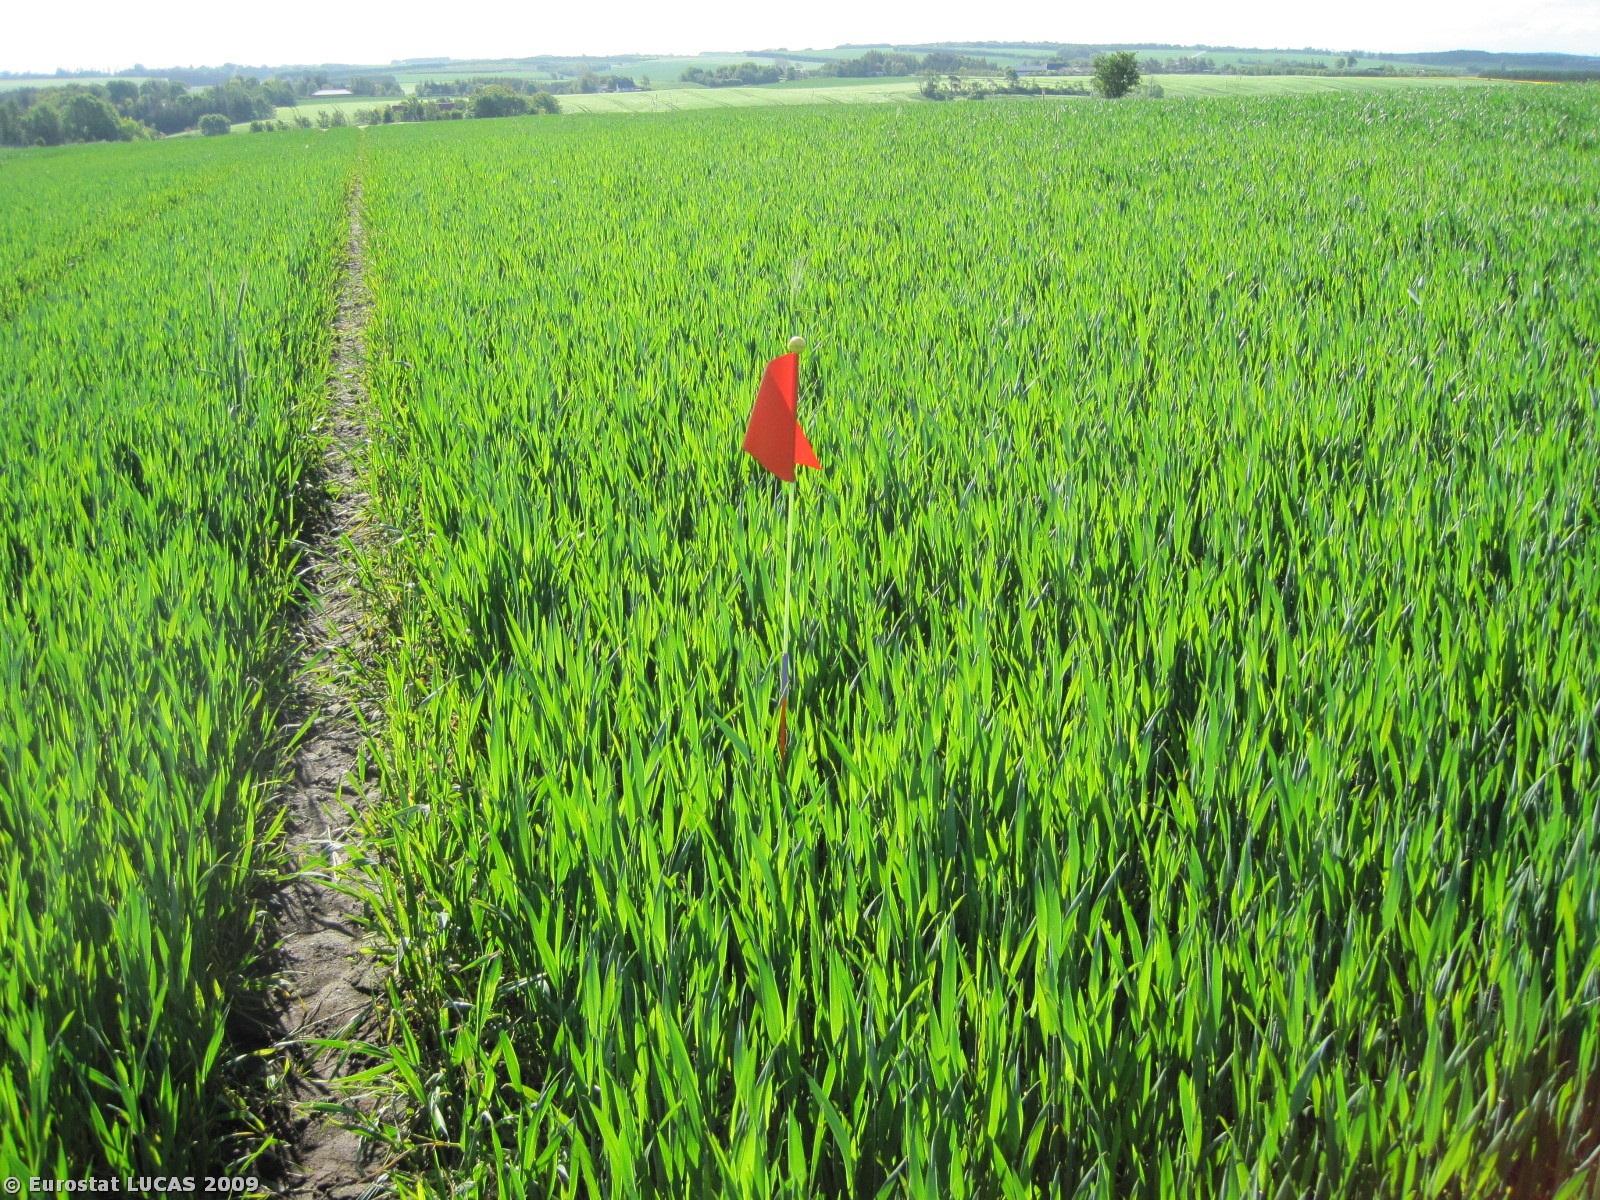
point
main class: Cropland
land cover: Common wheat
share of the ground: > 75 %
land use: Agriculture (excluding fallow land and kitchen gardens)
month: May
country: DK
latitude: 56.8708
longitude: 10.0164
